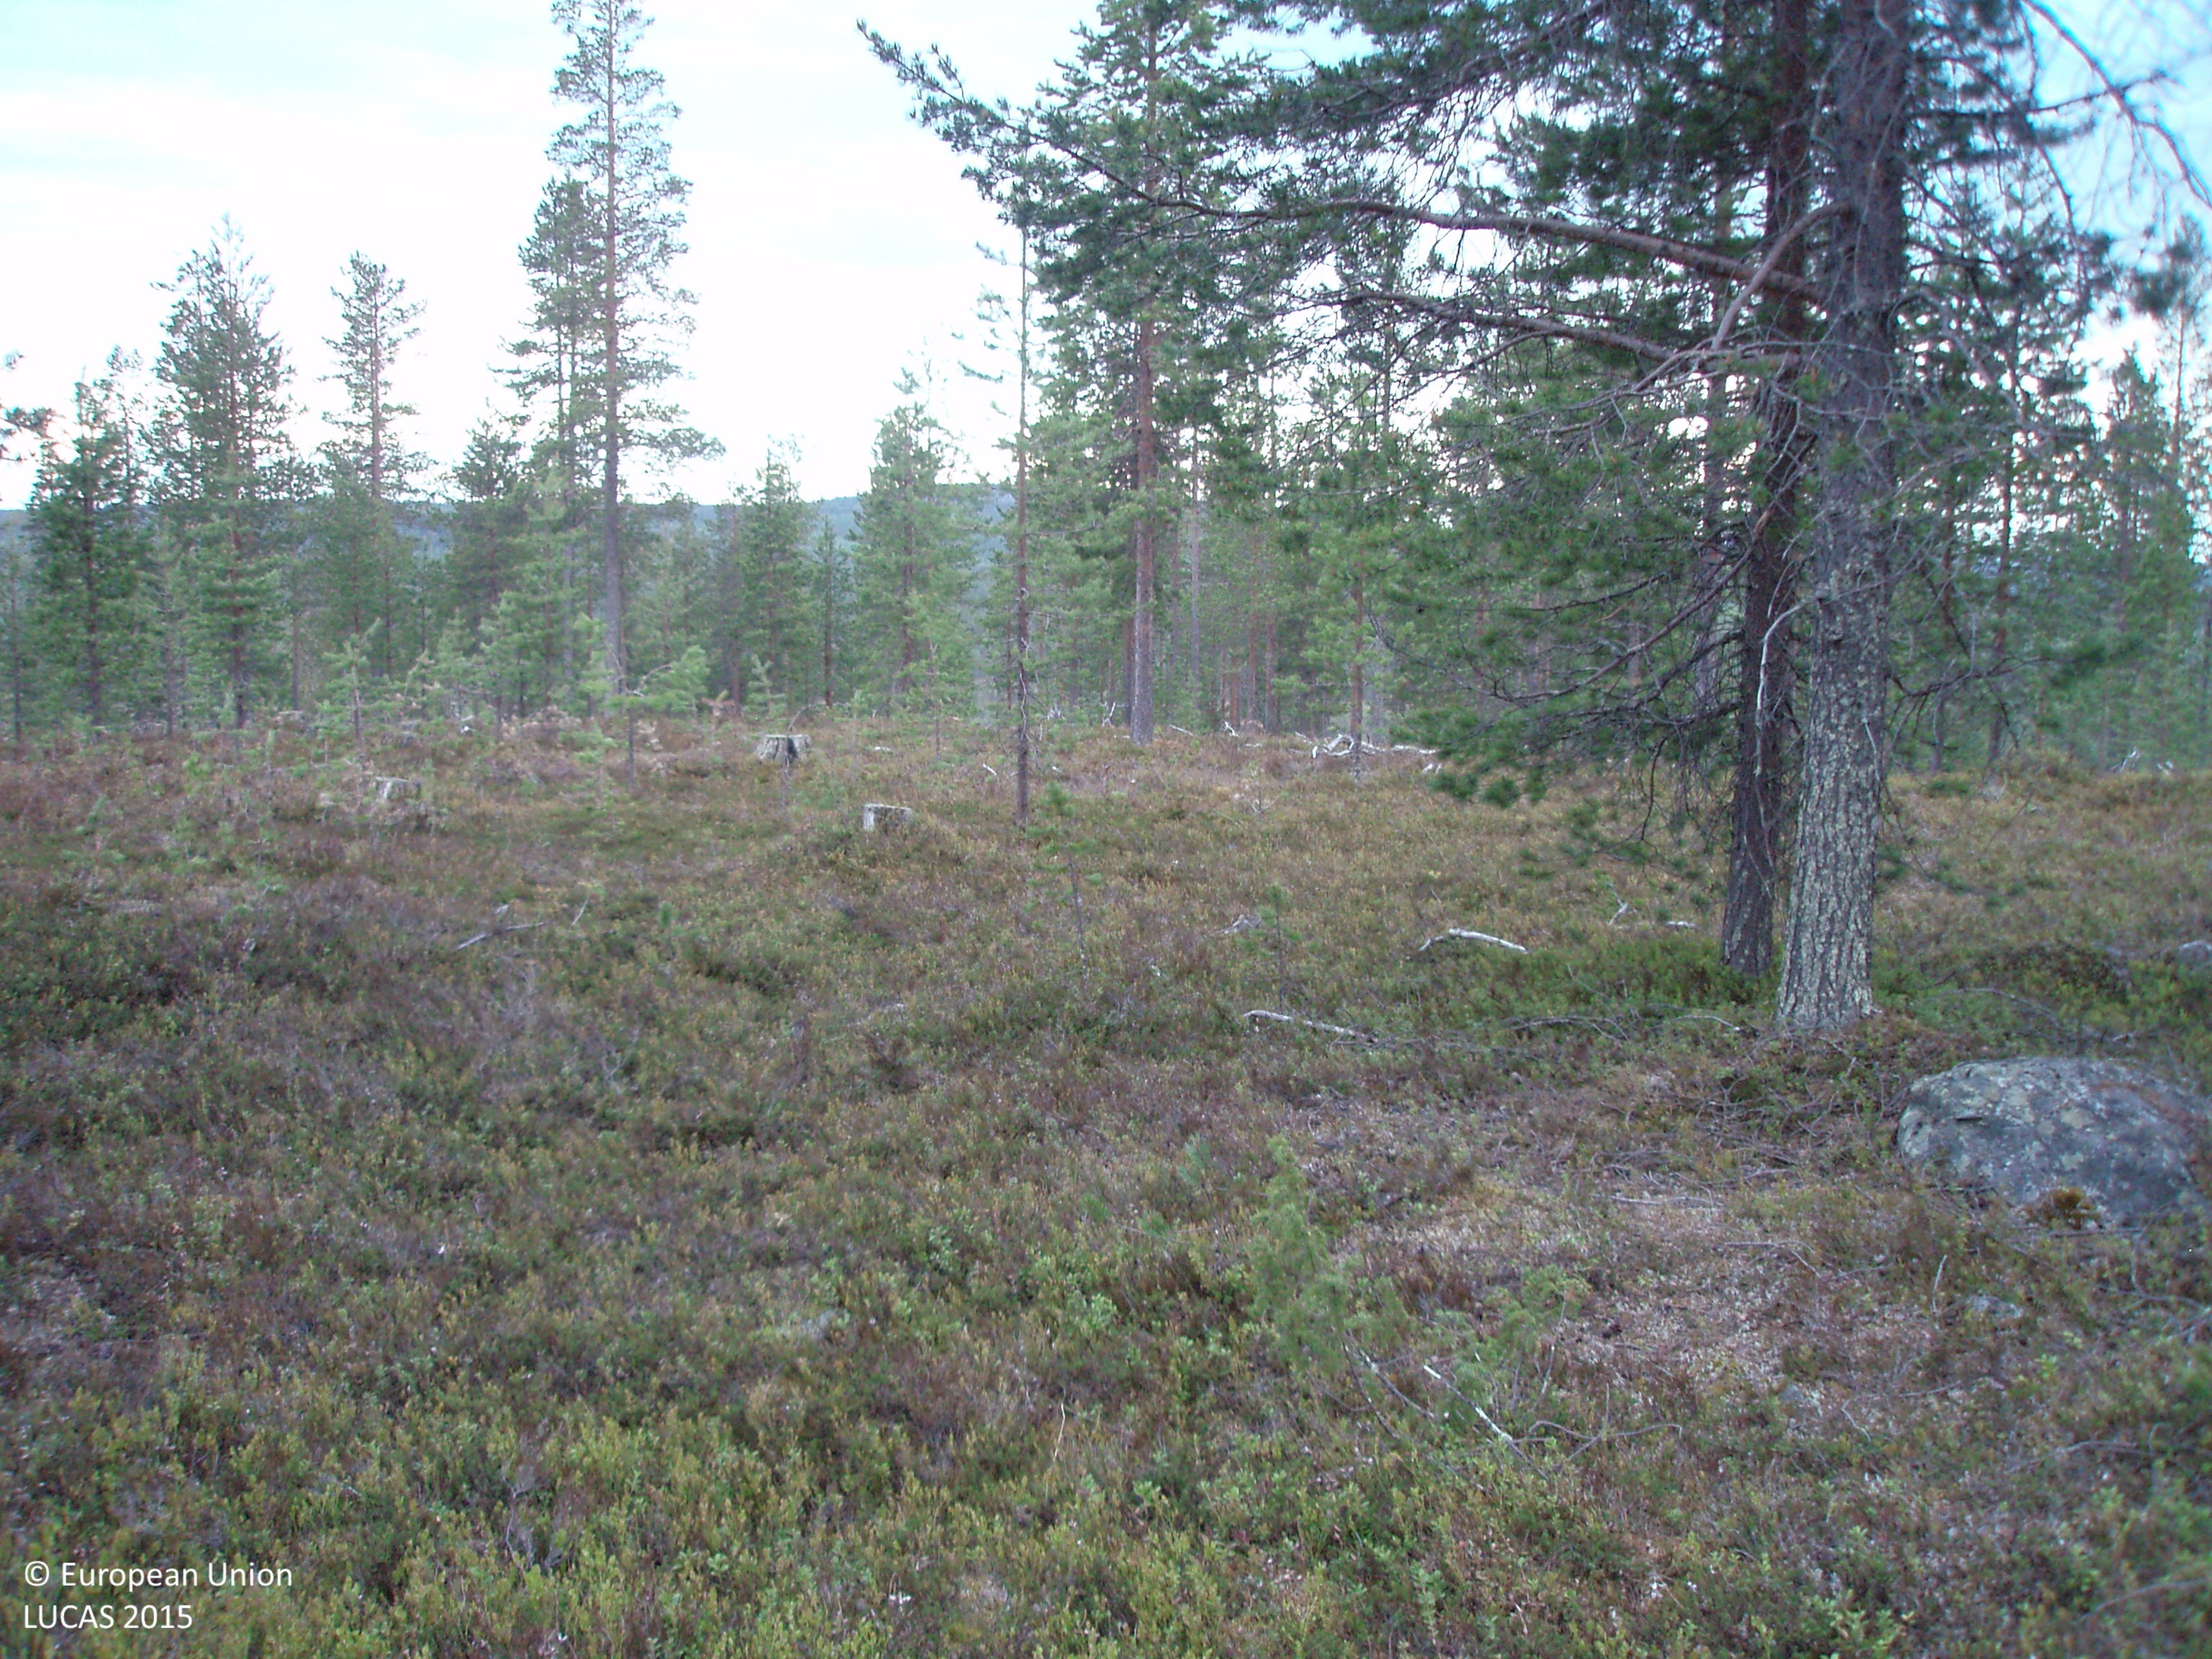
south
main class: Woodland
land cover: Pine dominated coniferous woodland
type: boreal forest
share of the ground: 50 - 75 %
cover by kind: coniferous forest trees 50 %, shrubs 45 %, broadleaved forest trees 5 %
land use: Forestry
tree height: > 5 m
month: June
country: FI
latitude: 67.3598
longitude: 27.0105
